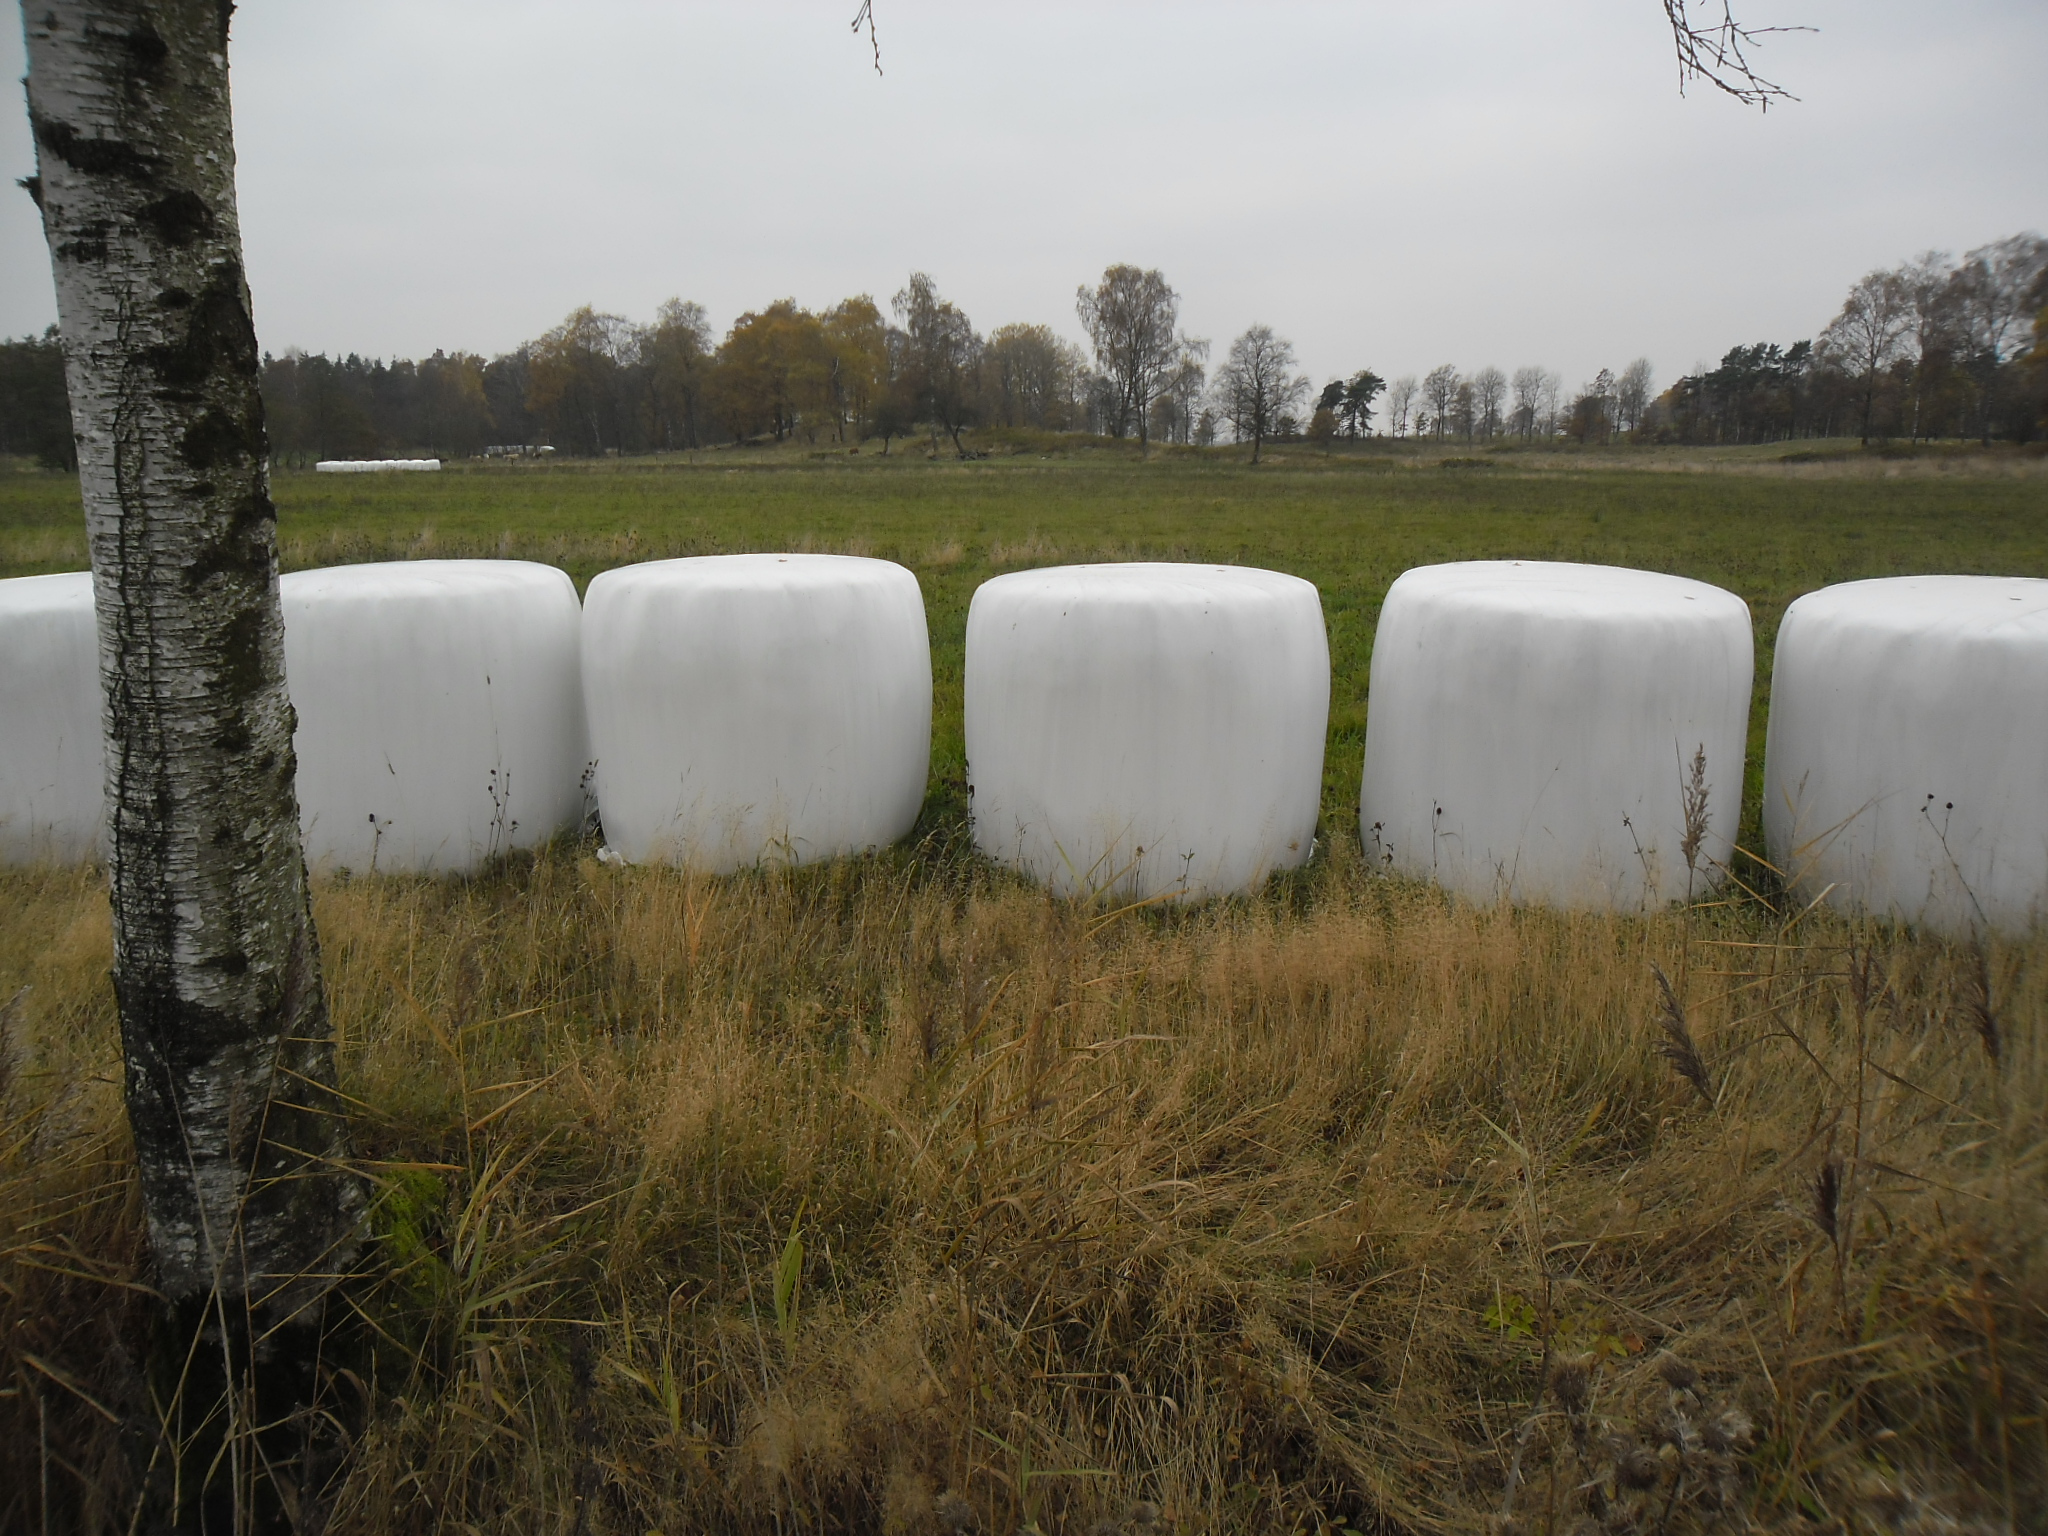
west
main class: Grassland
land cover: Grassland without tree/shrub cover
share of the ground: > 75 %
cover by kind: herbaceous plants 100 %
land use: Agriculture (excluding fallow land and kitchen gardens)
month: October
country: SE
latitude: 56.4719
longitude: 13.1950
